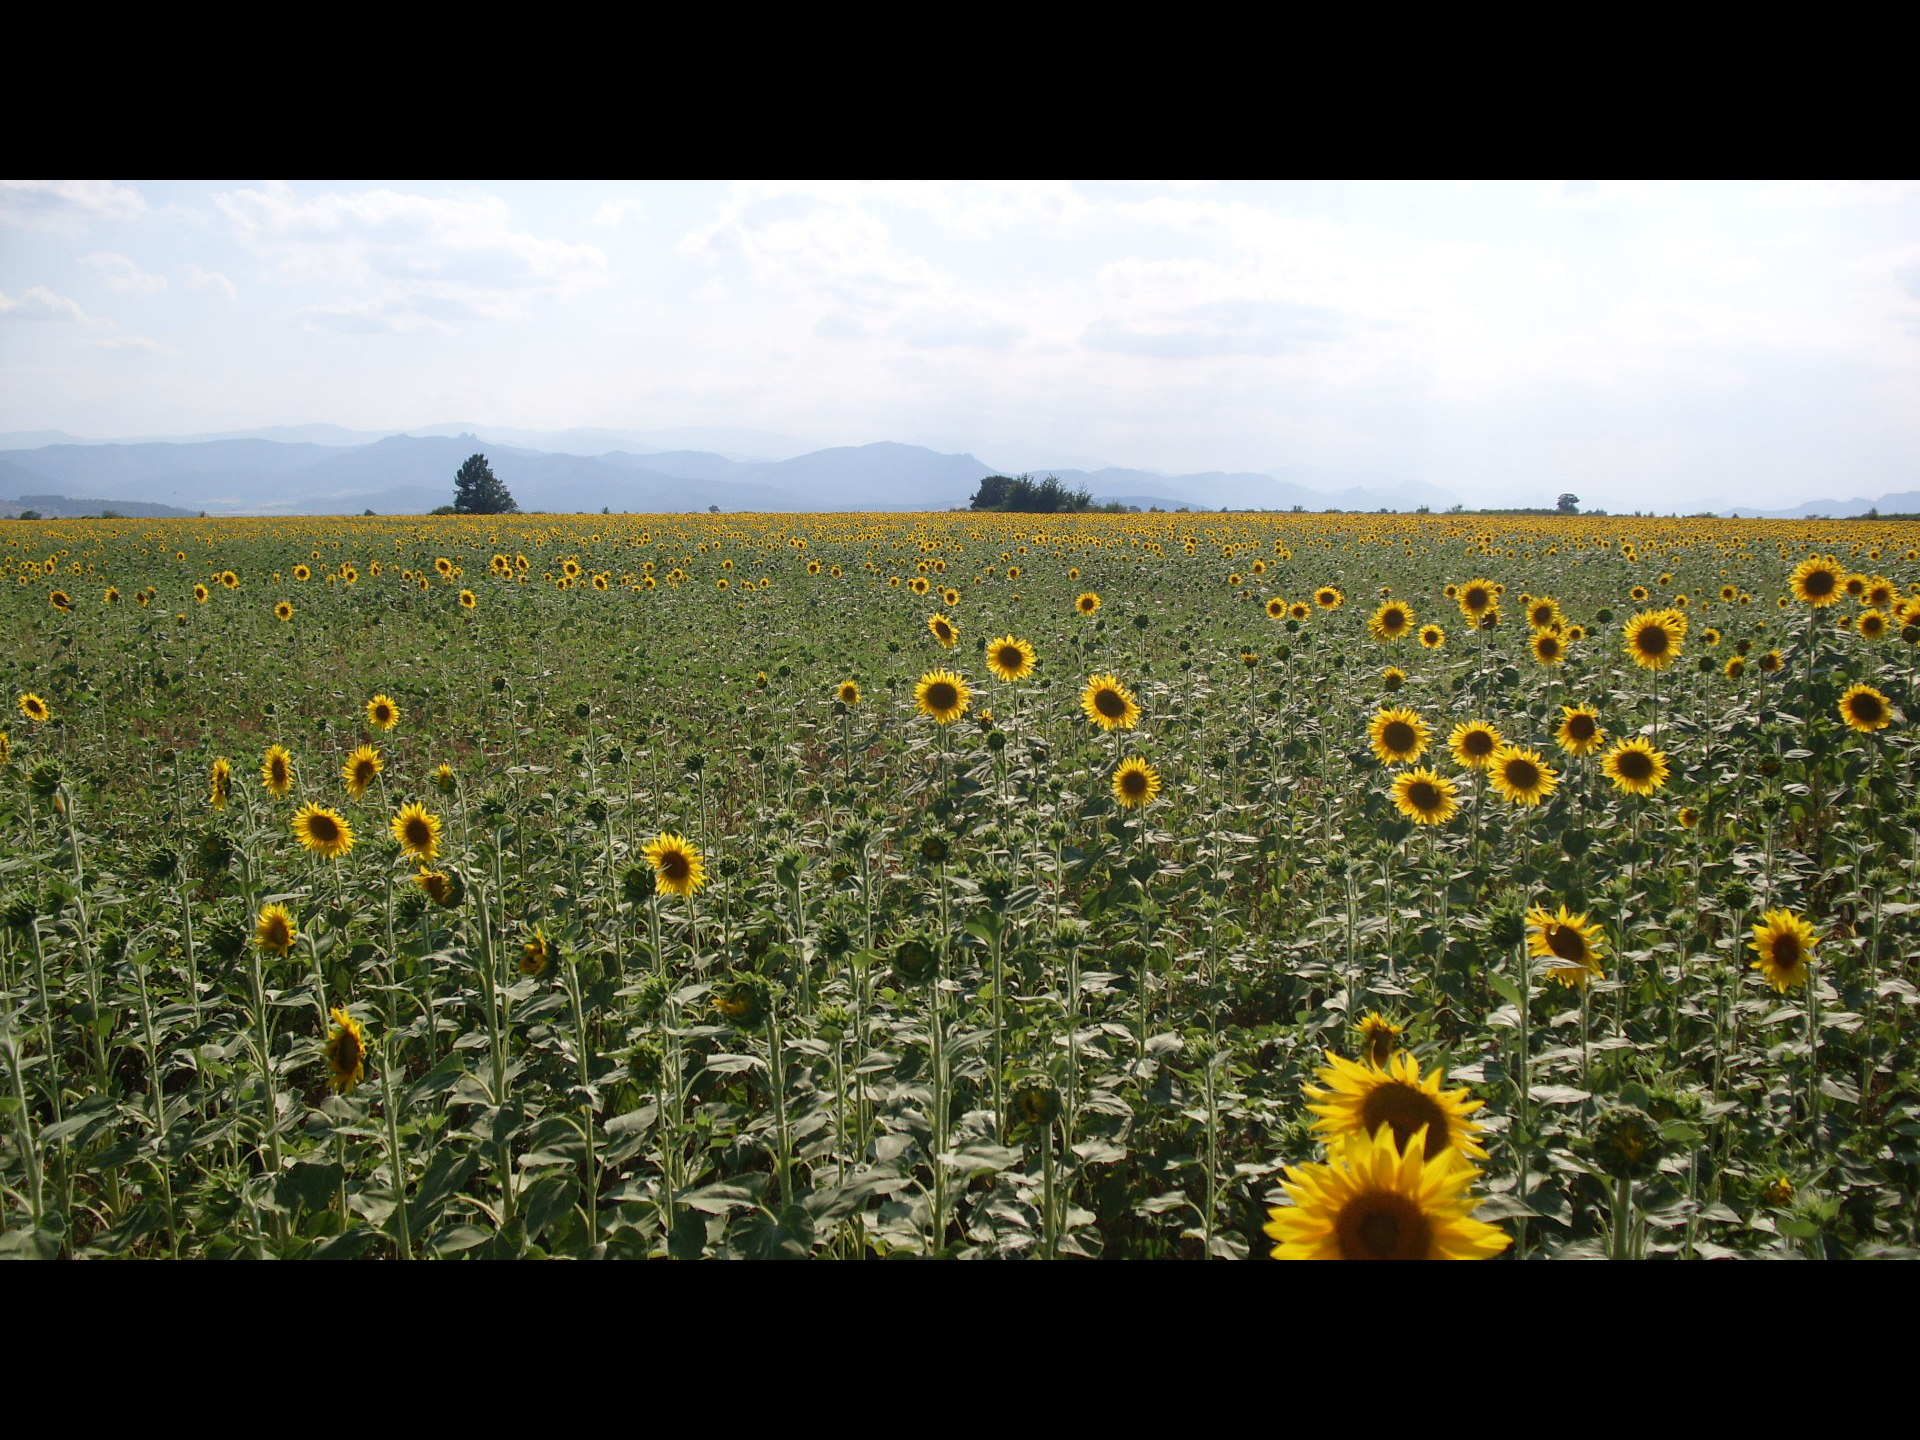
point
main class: Cropland
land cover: Sunflower
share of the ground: > 75 %
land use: Agriculture (excluding fallow land and kitchen gardens)
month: August
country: BG
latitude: 43.5799
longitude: 23.0289
